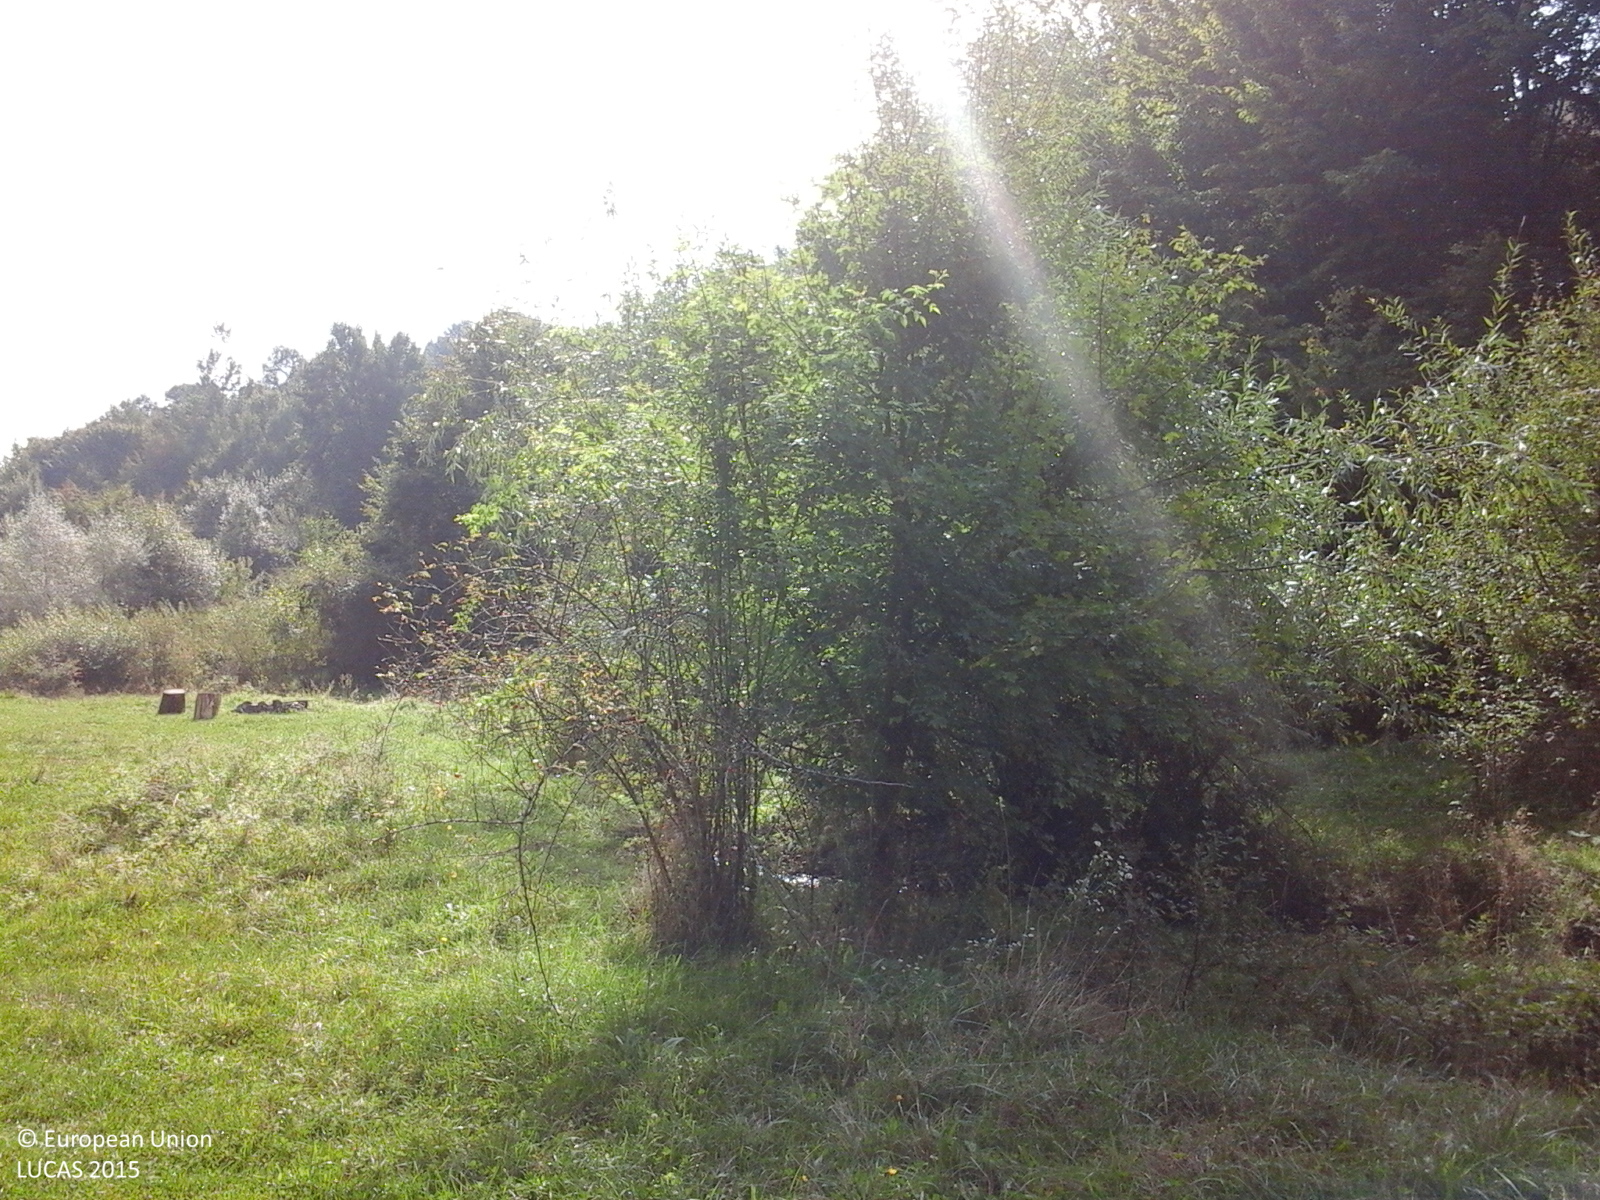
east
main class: Woodland
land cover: Broadleaved woodland
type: mesophytic deciduous forest
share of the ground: > 75 %
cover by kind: broadleaved forest trees 100 %
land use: Forestry
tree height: > 5 m
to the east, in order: Broadleaved woodland; Tracks; Broadleaved woodland
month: September
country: RO
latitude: 46.8009
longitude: 22.9400
